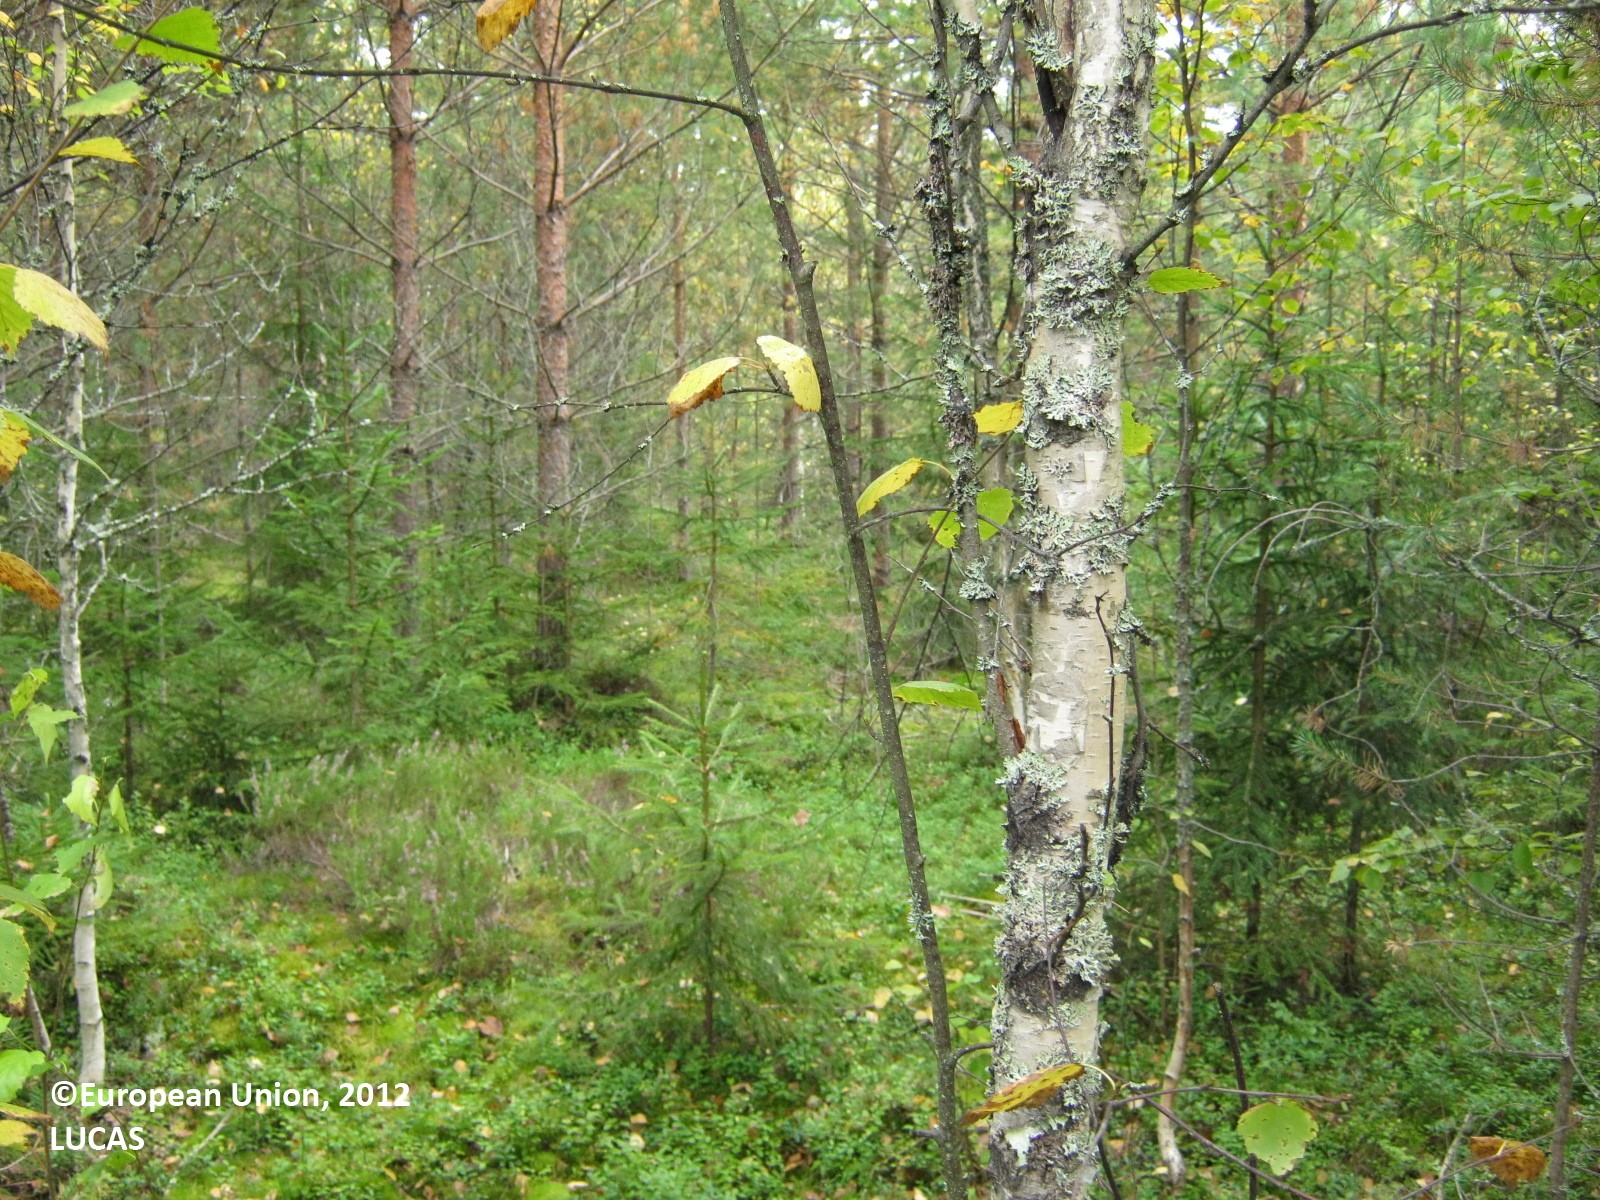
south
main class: Woodland
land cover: Pine dominated mixed woodland
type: boreal forest
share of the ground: > 75 %
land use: Forestry
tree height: > 5 m
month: September
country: FI
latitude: 60.5810
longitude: 27.5818
